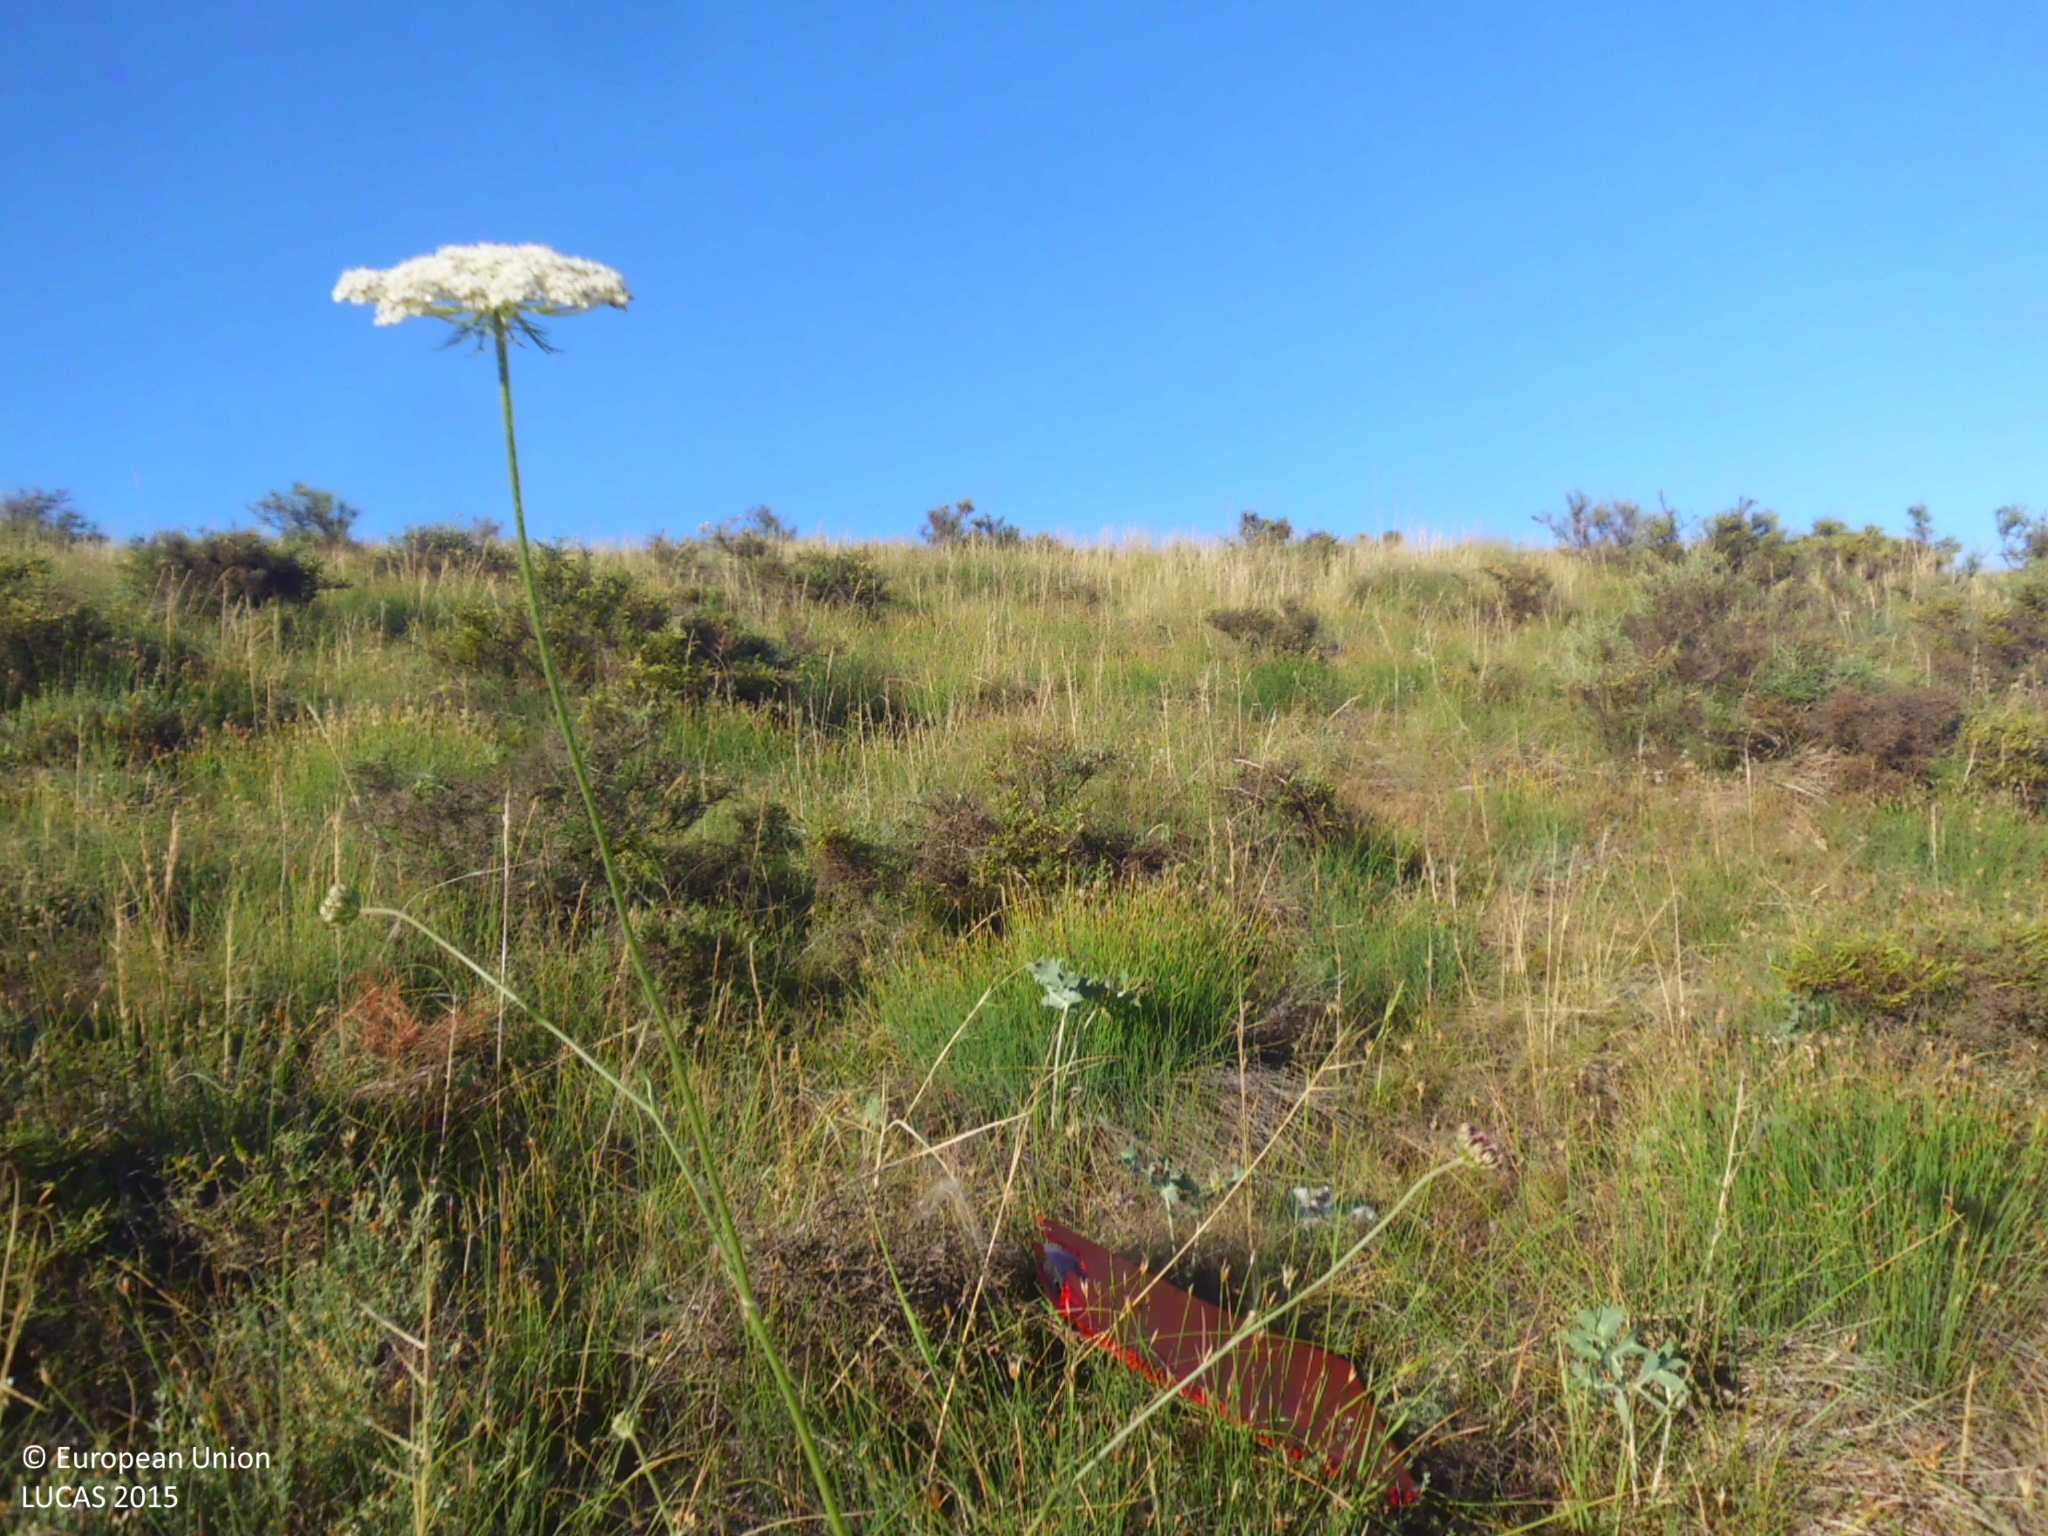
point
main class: Shrubland
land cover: Shrubland without tree cover
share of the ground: 50 - 75 %
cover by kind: shrubs 60 %, herbaceous plants 30 %, consolidated bare surface 10 %
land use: Semi-natural and natural areas not in use
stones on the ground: 25 - 50 %
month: July
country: ES
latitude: 42.6287
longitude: -4.2537
